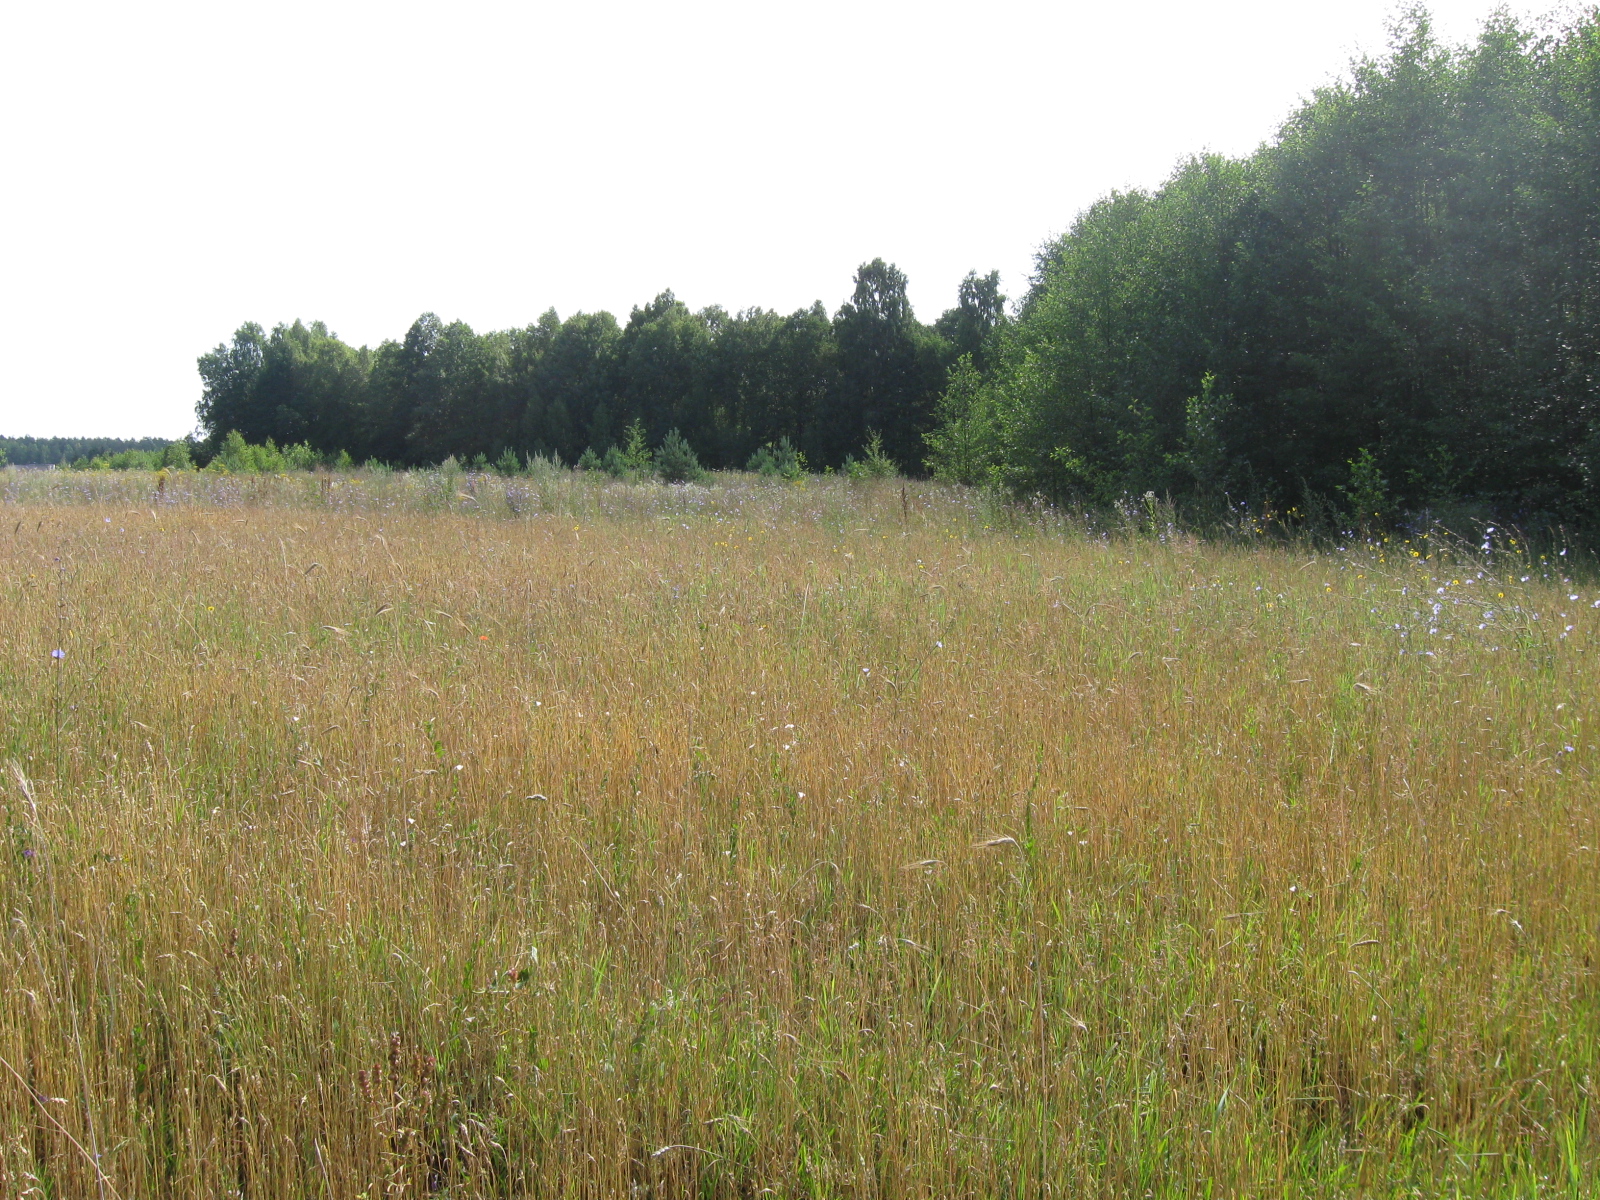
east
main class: Cropland
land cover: Common wheat
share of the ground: > 75 %
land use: Agriculture (excluding fallow land and kitchen gardens)
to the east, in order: Common wheat; Grassland without tree/shrub cover; Grassland with sparse tree/shrub cover; Broadleaved woodland; Inland marshes; Broadleaved woodland
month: July
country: LT
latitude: 54.0502
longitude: 23.7894
